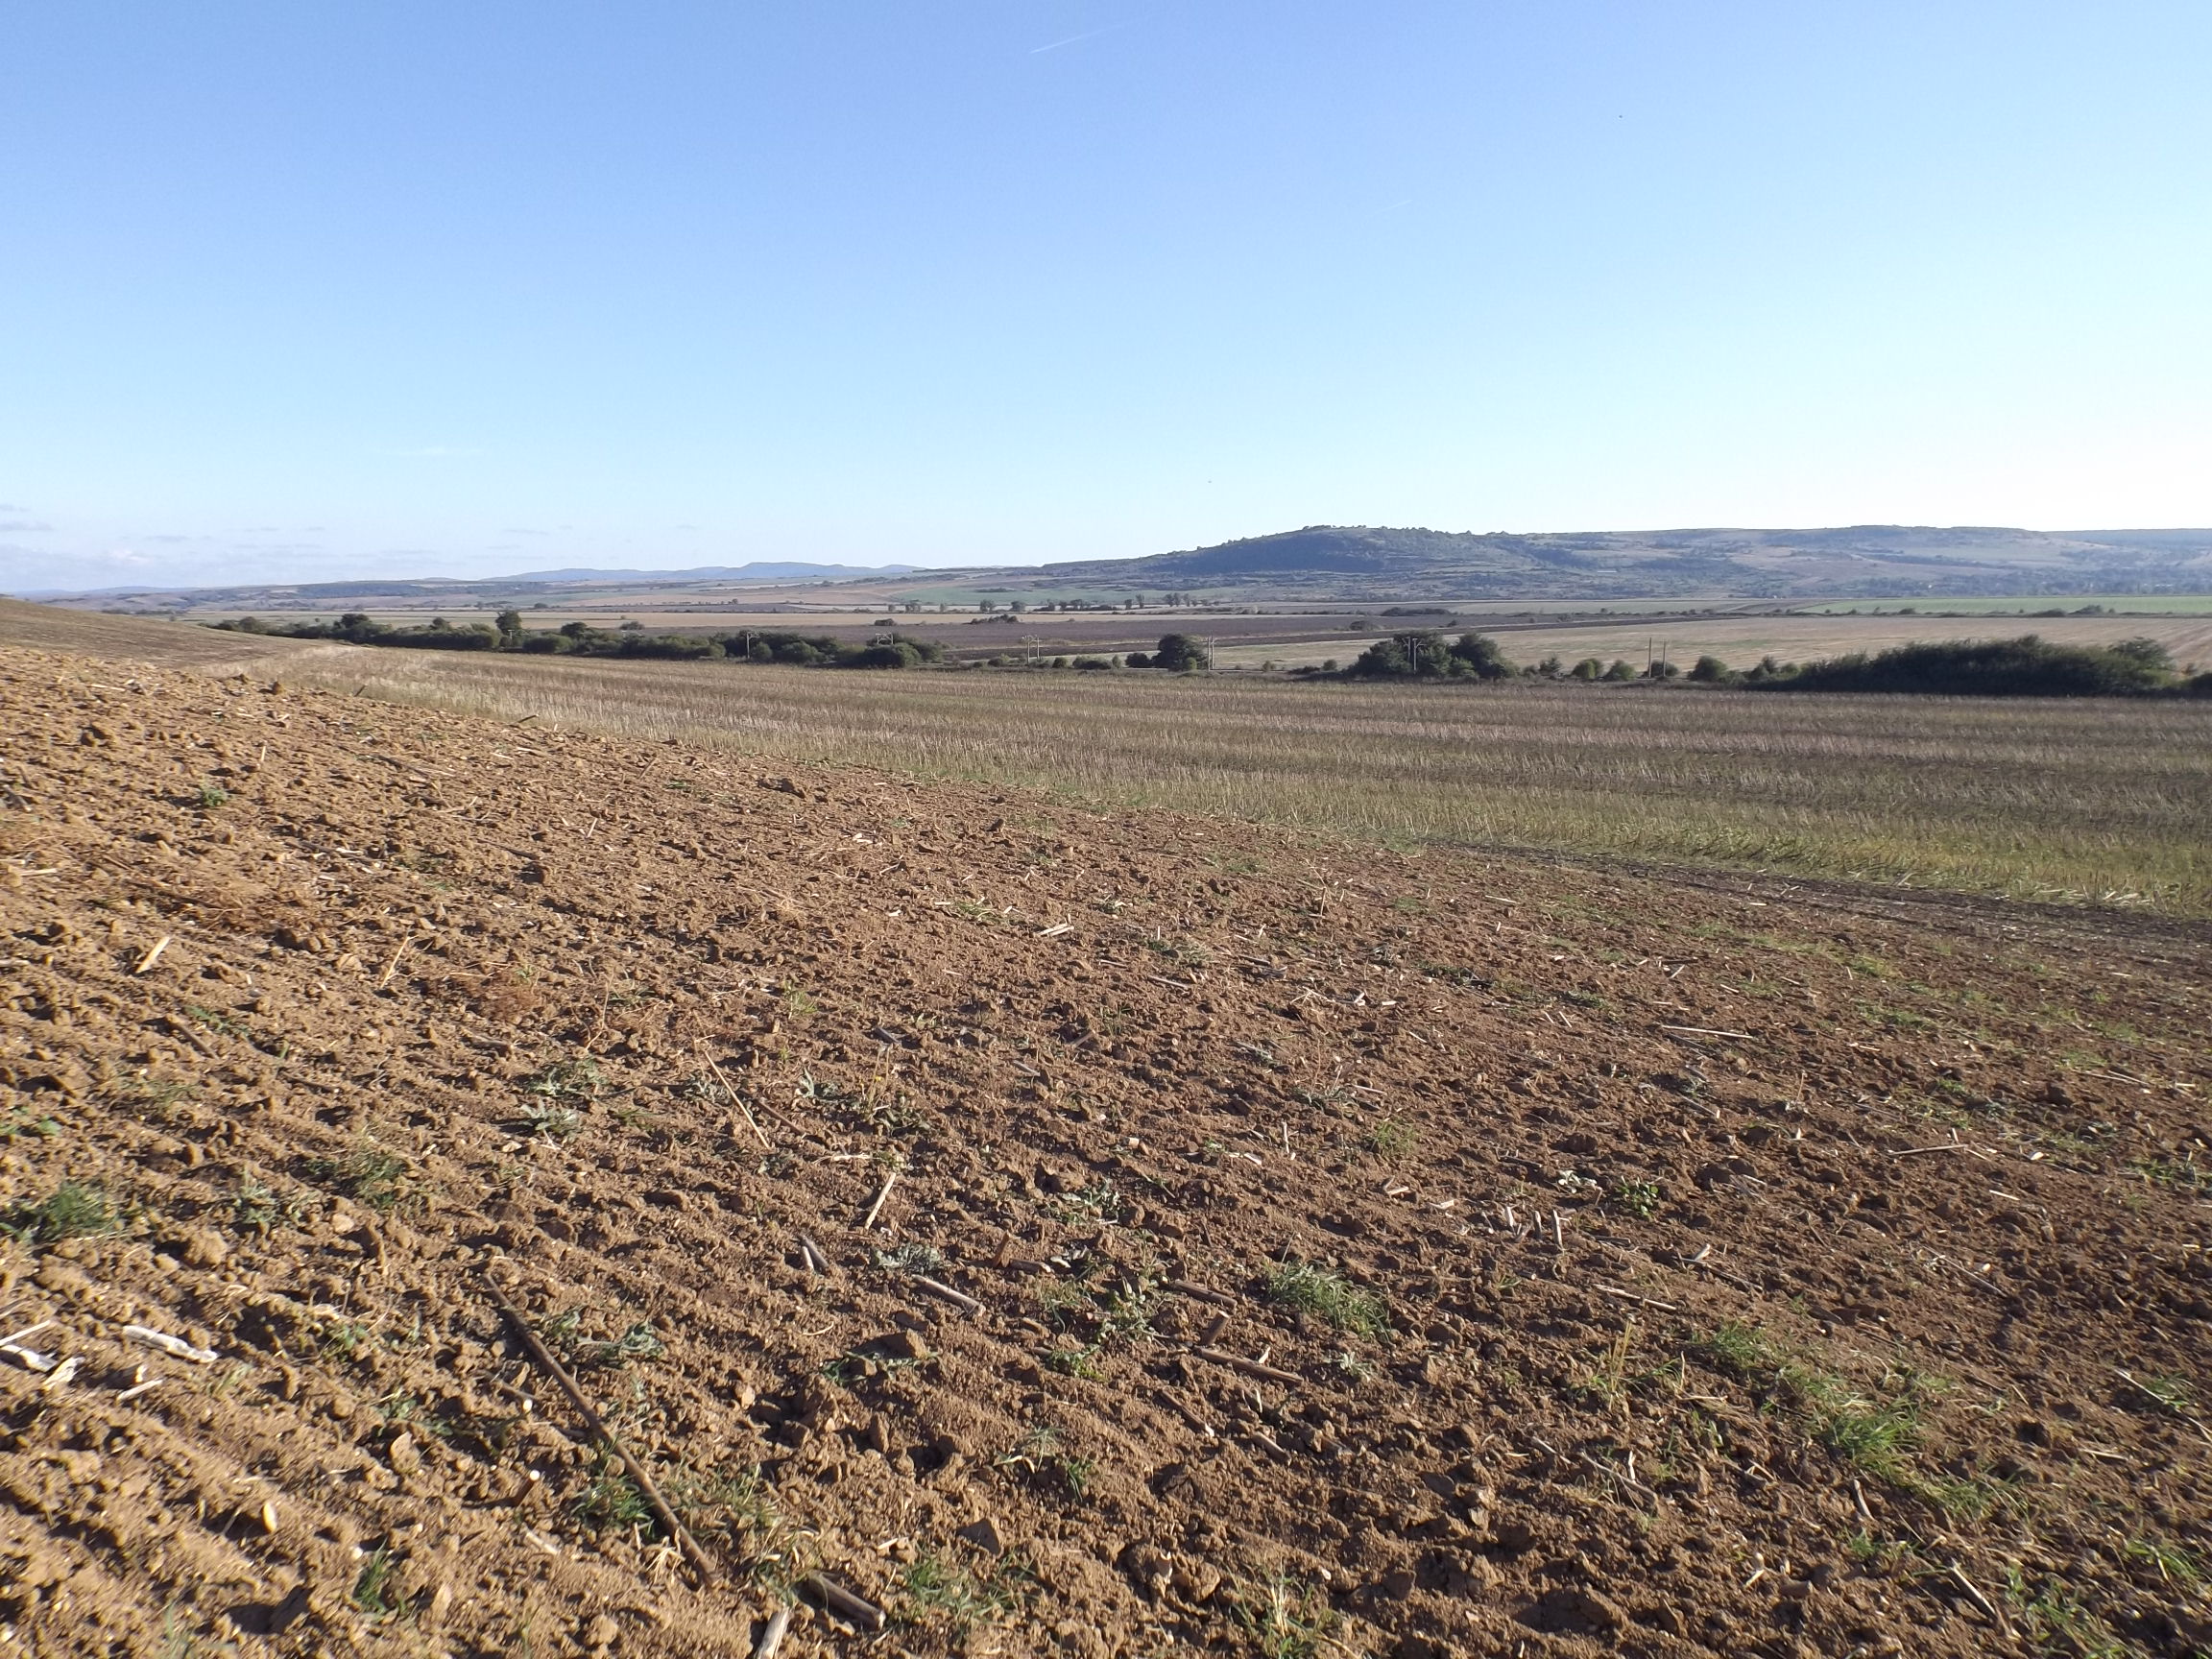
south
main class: Cropland
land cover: Sunflower
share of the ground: < 10 %
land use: Agriculture (excluding fallow land and kitchen gardens)
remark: Harvested field
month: September
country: BG
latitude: 43.1265
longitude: 27.4947
